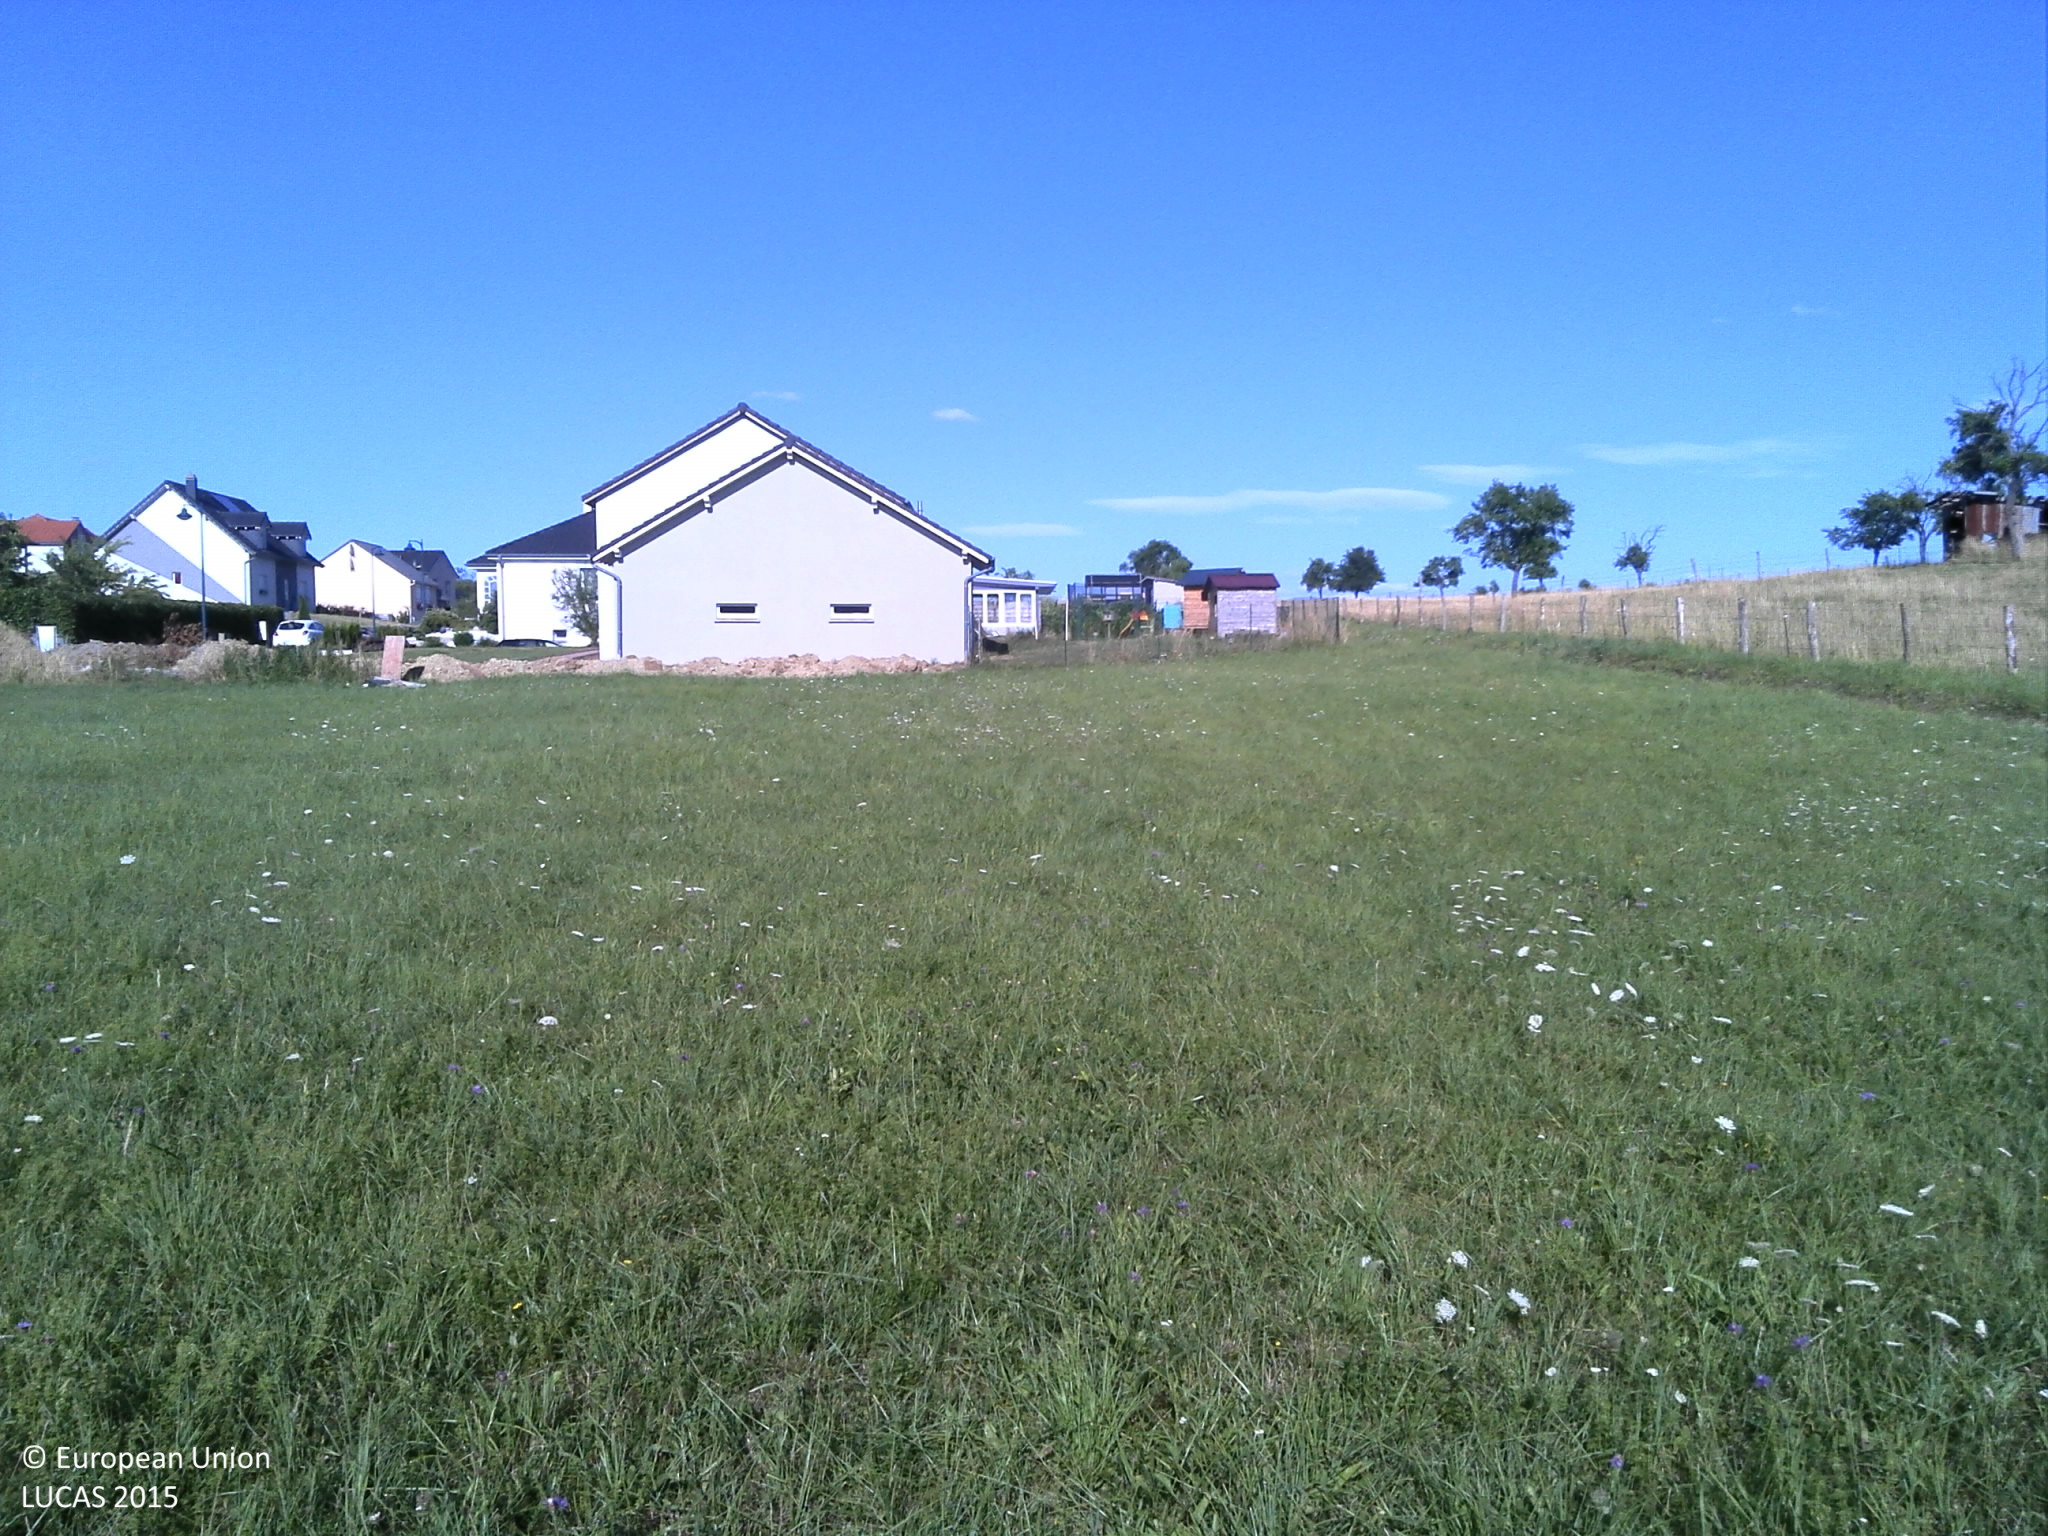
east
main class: Grassland
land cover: Grassland without tree/shrub cover
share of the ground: > 75 %
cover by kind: herbaceous plants 100 %
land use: Residential
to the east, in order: Grassland without tree/shrub cover; Ditches and canals; Grass margins; Fences; Grassland without tree/shrub cover; Fences; Grassland with sparse tree/shrub cover; Grassland without tree/shrub cover
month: July
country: FR
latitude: 49.0727
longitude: 7.3038
